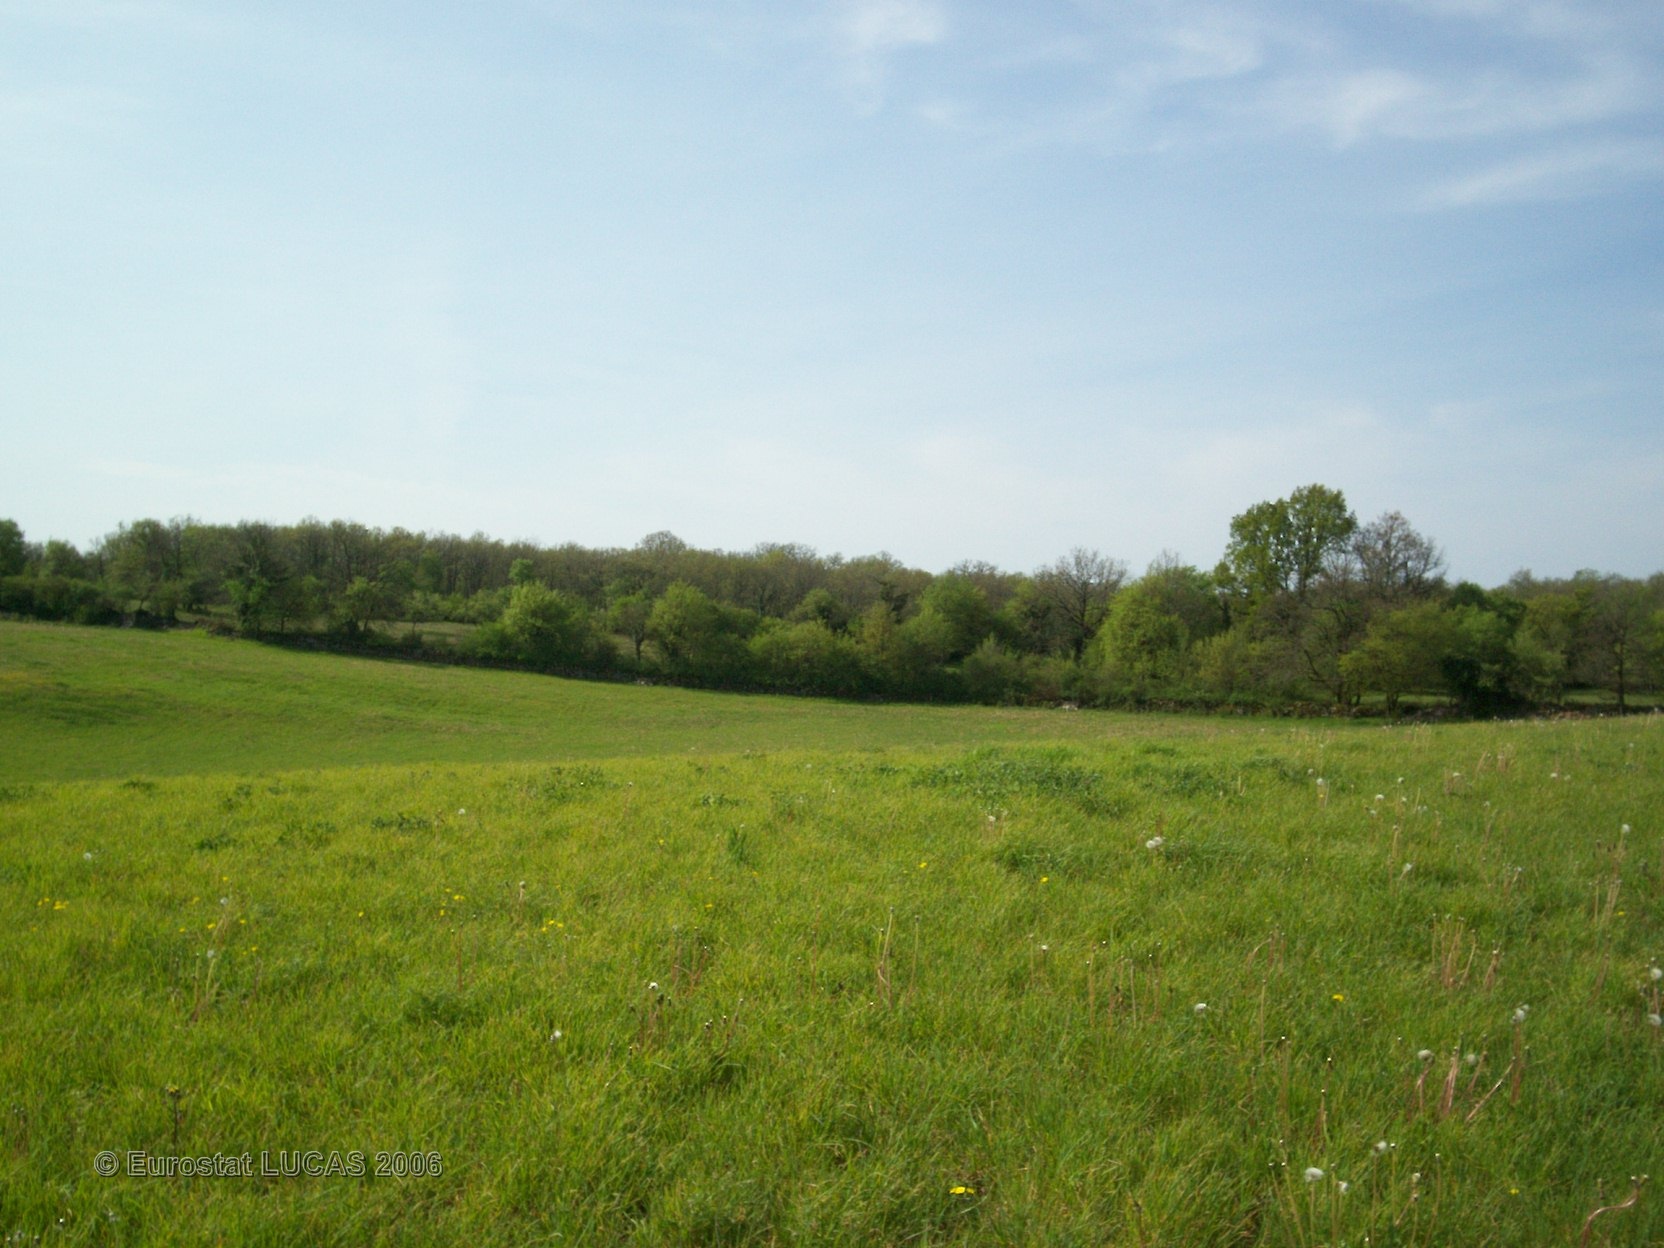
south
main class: Grassland
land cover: Grassland without tree/shrub cover
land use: Agriculture (excluding fallow land and kitchen gardens)
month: May
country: FR
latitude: 44.6967
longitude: 1.8088
